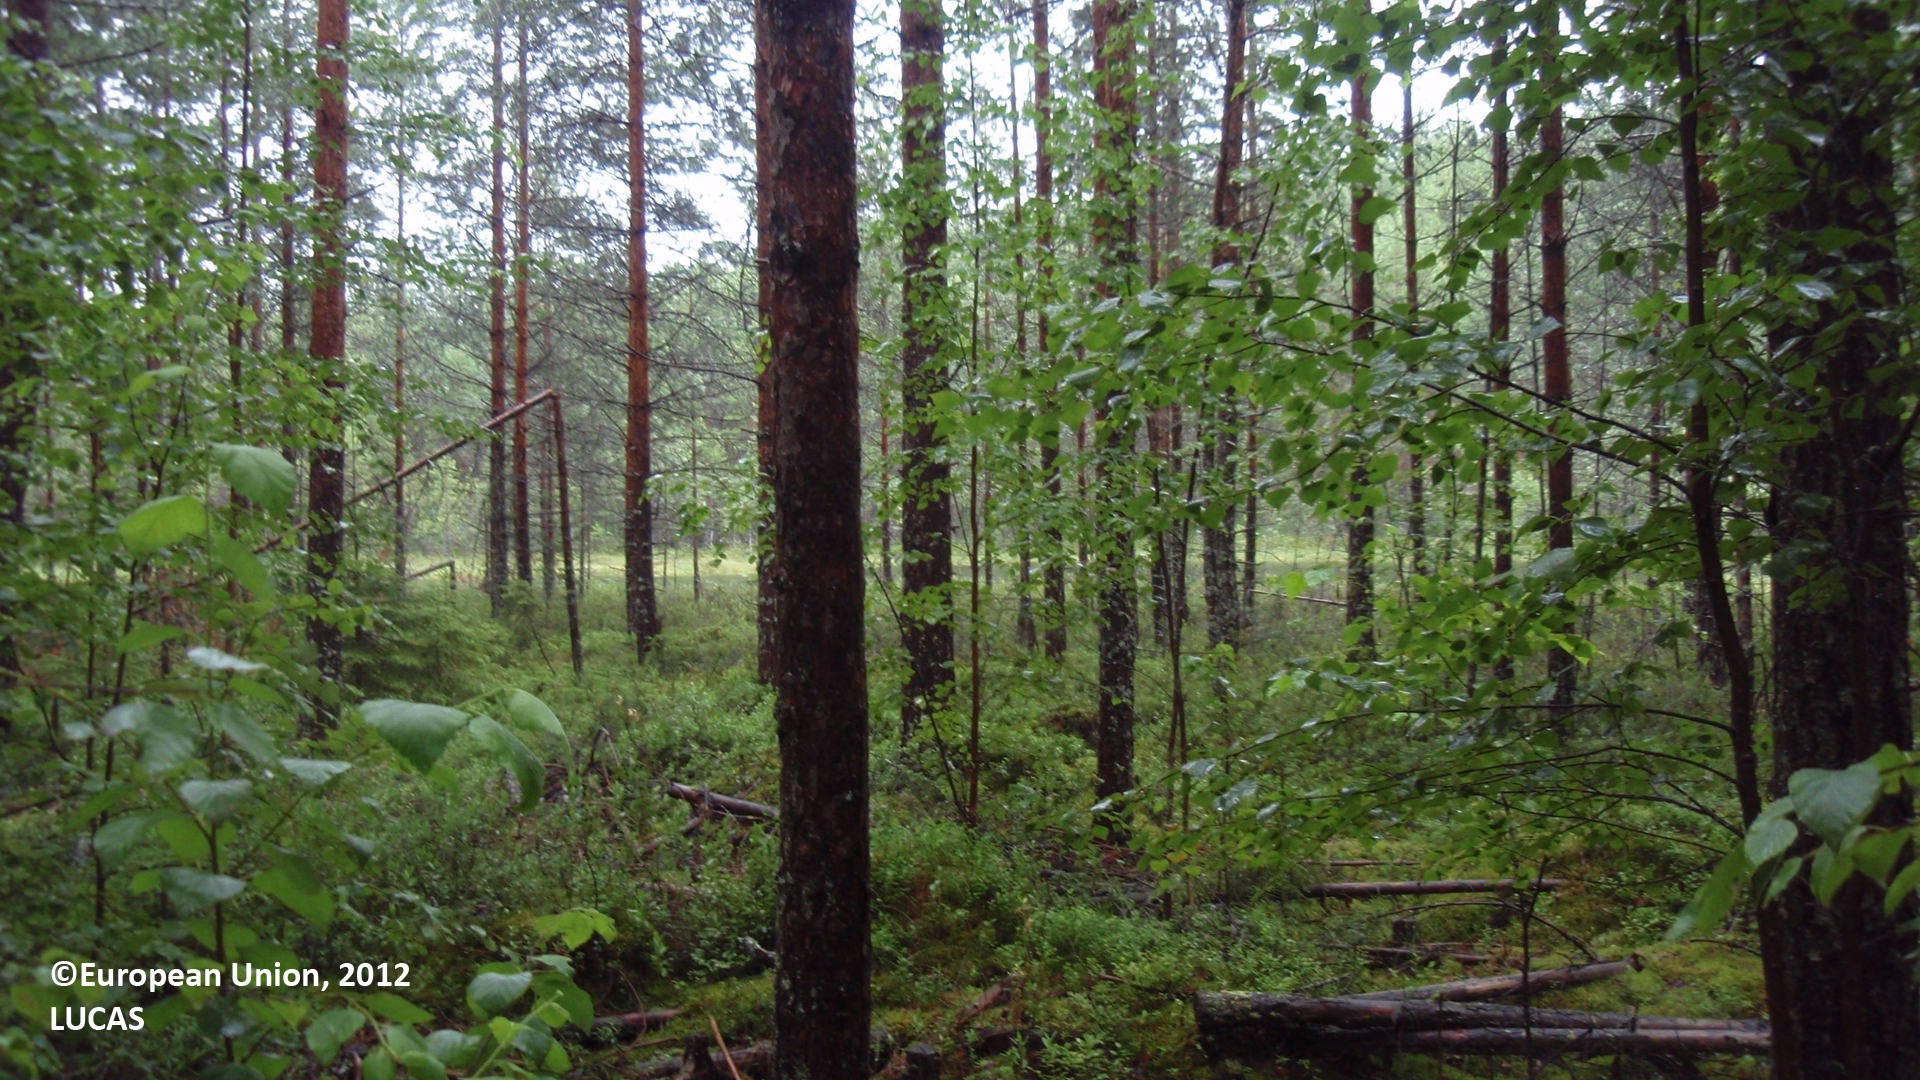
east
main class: Woodland
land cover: Pine dominated mixed woodland
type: boreal forest
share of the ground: > 75 %
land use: Forestry
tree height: > 5 m
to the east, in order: Pine dominated mixed woodland; Ditches and canals; Pine dominated mixed woodland; Inland marshes; Inland water bodies; Inland marshes; Spruce dominated coniferous woodland; Pine dominated mixed woodland
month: July
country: FI
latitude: 61.4286
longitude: 27.0138
